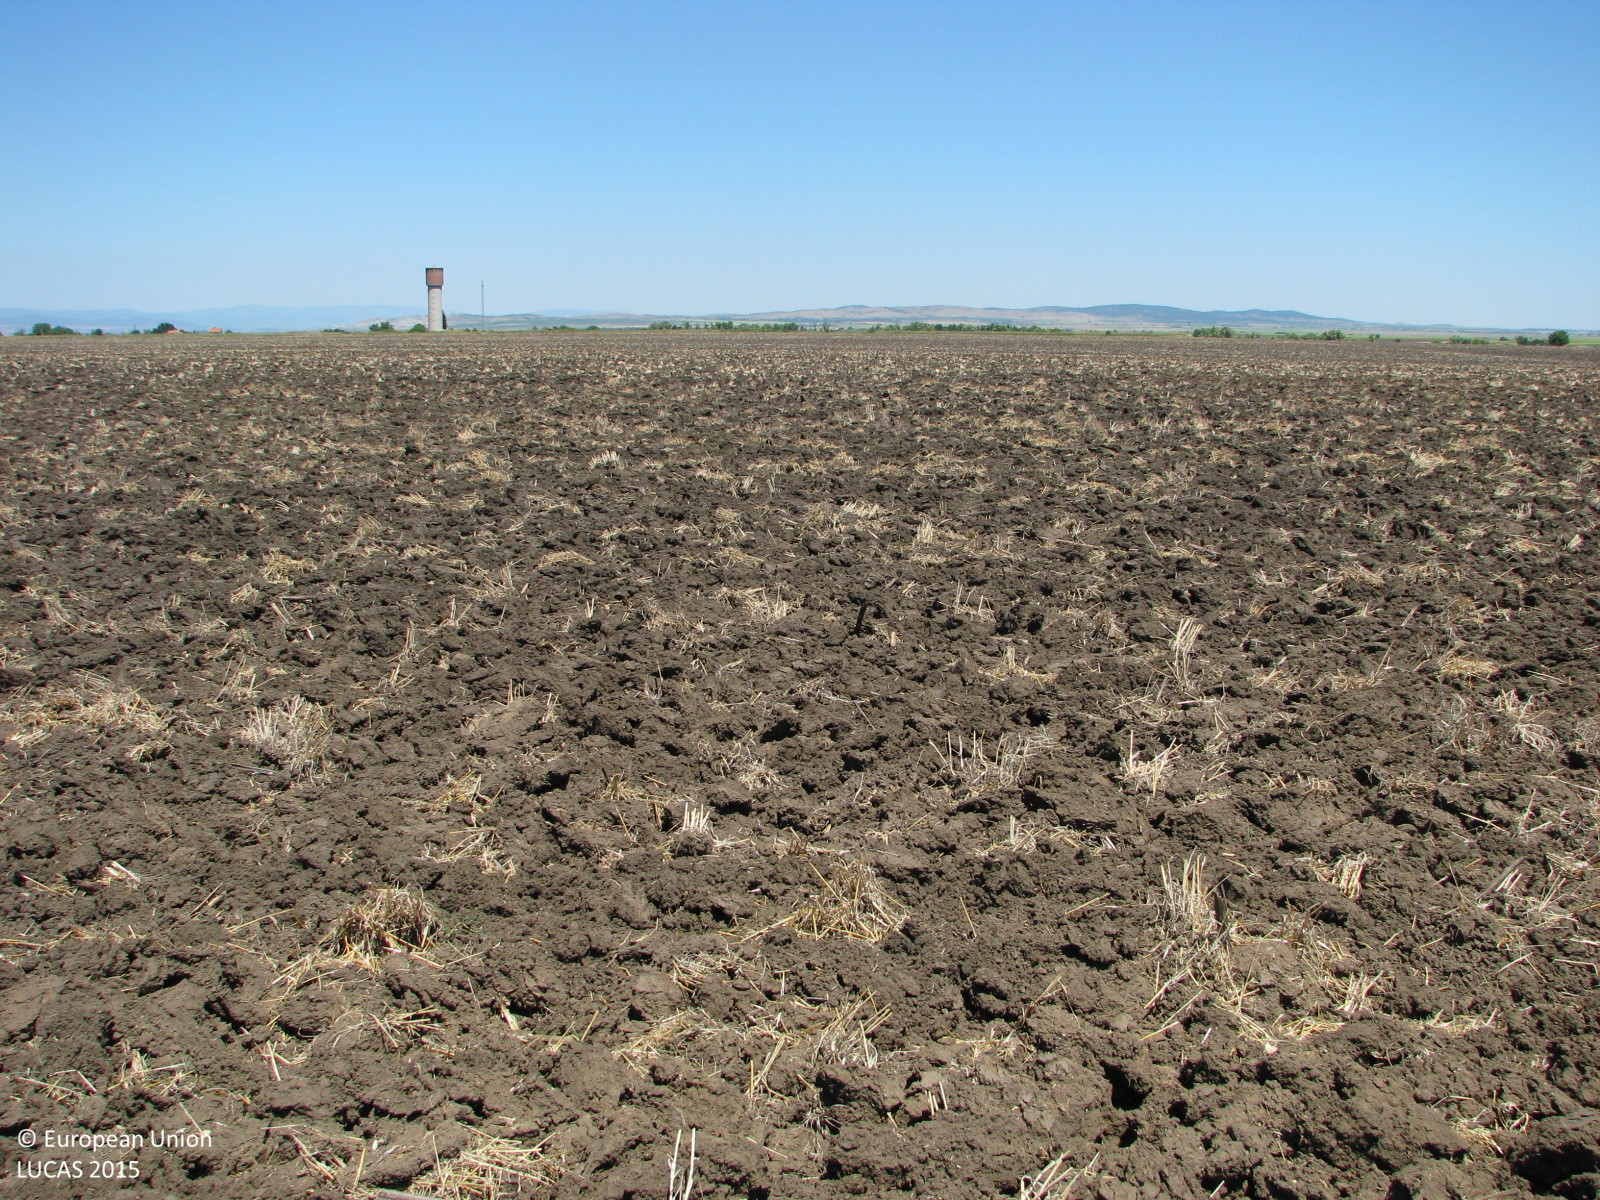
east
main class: Cropland
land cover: Common wheat
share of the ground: < 10 %
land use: Agriculture (excluding fallow land and kitchen gardens)
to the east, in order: Common wheat
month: July
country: BG
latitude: 42.3550
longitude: 25.9455
